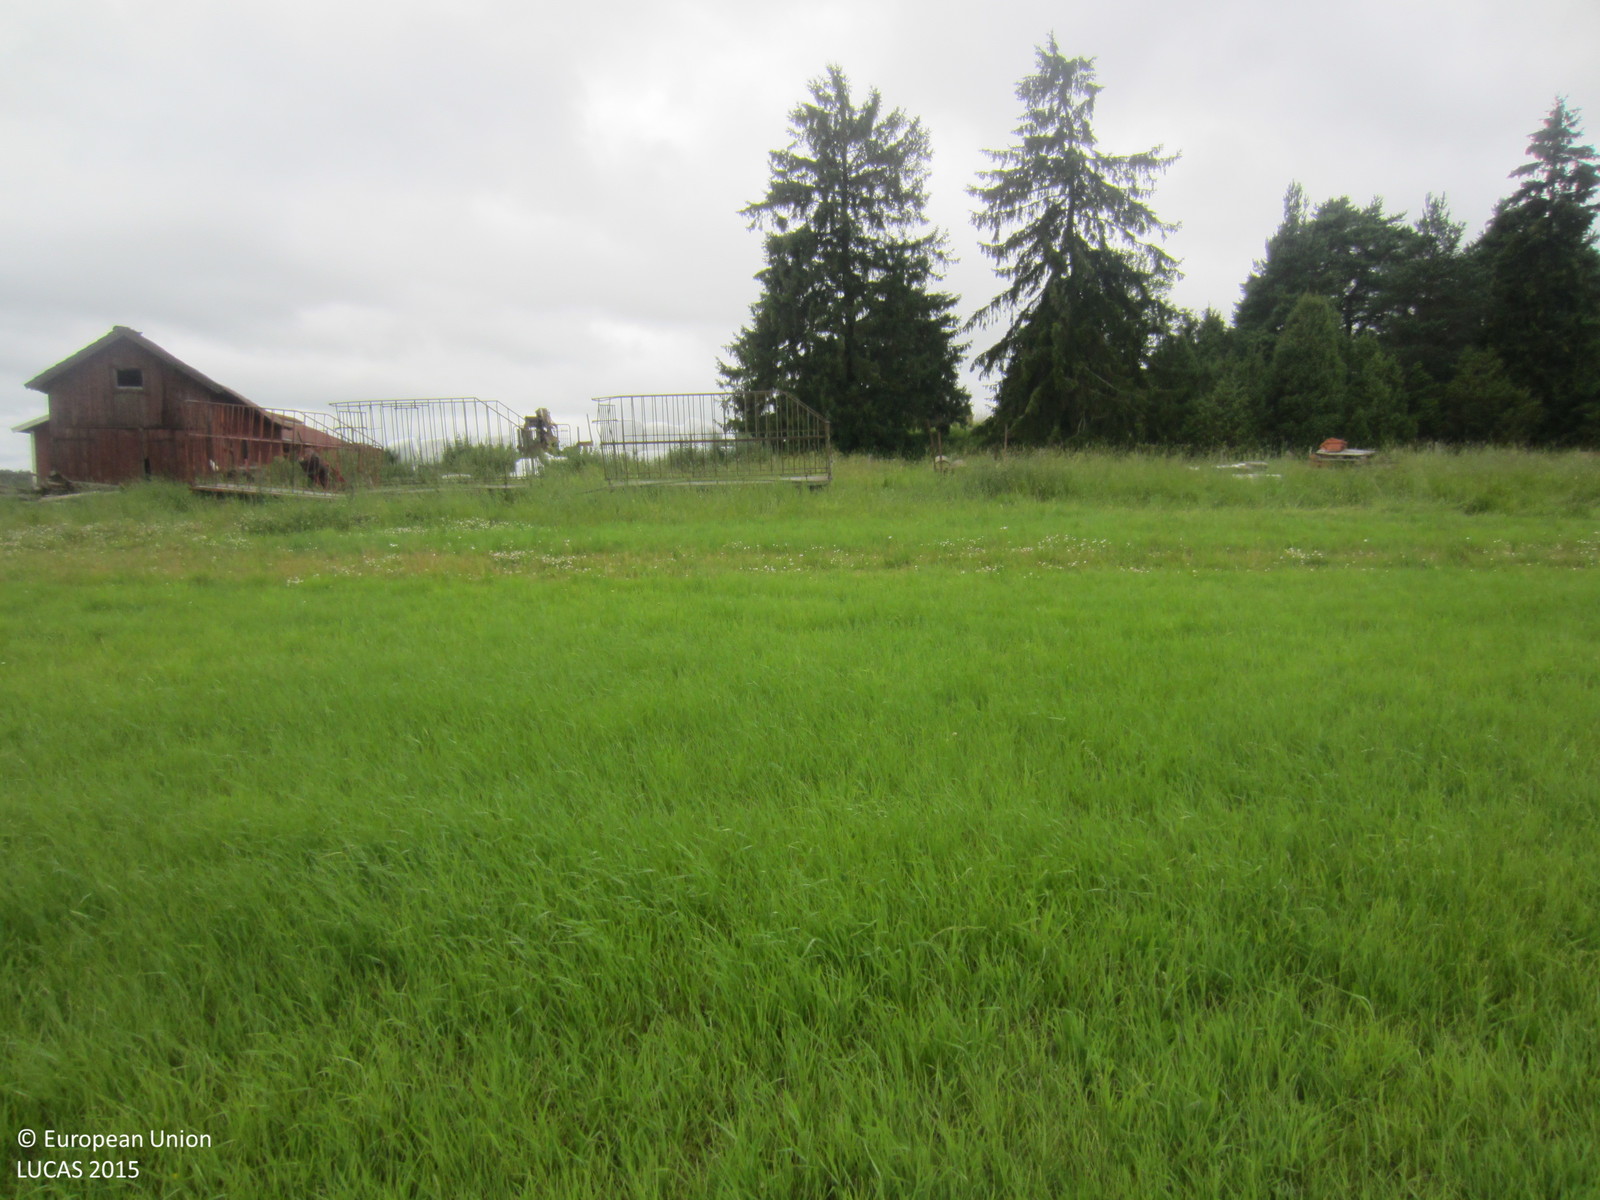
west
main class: Grassland
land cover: Grassland without tree/shrub cover
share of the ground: > 75 %
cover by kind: herbaceous plants 100 %
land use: Agriculture (excluding fallow land and kitchen gardens)
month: July
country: SE
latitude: 59.8009
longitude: 17.1400
